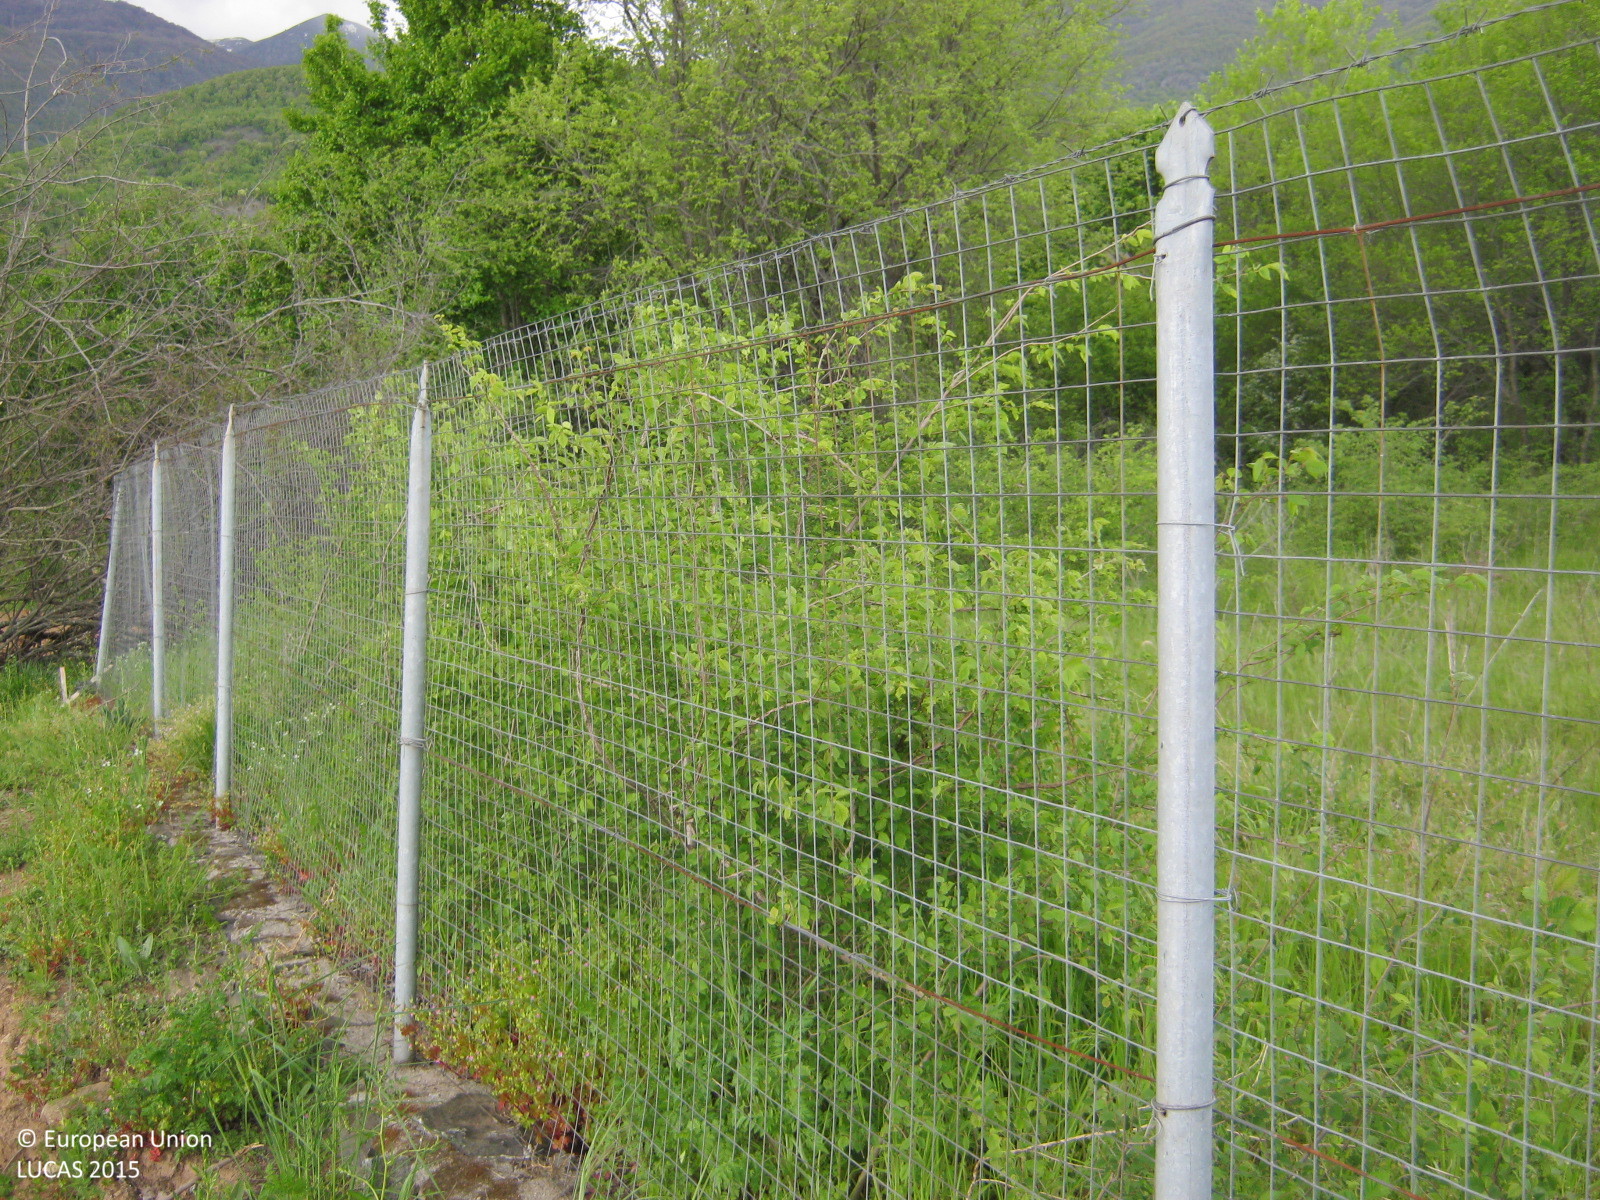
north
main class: Grassland
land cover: Spontaneously vegetated surfaces
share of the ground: > 75 %
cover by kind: herbaceous plants 100 %
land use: Fallow land
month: April
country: GR
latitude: 41.2728
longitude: 23.2090
